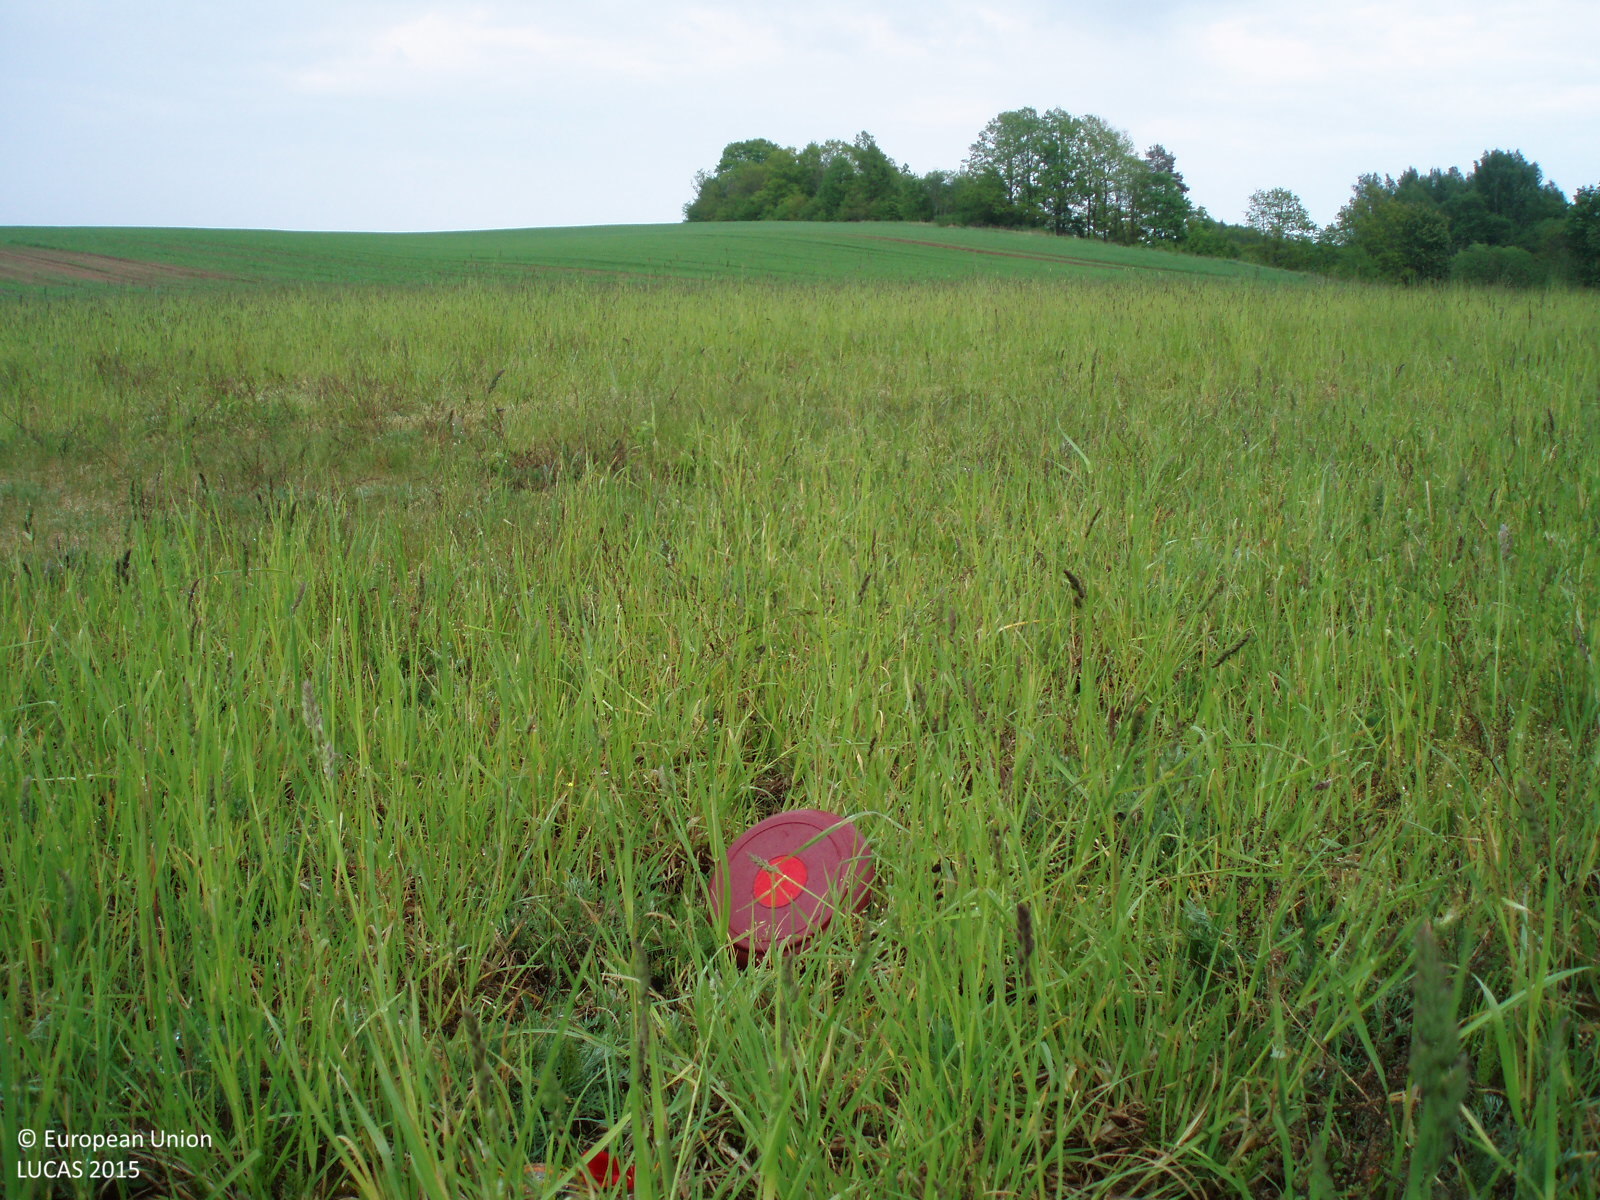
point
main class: Grassland
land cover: Grassland without tree/shrub cover
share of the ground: > 75 %
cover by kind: herbaceous plants 70 %, lichens and mosses 30 %
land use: Agriculture (excluding fallow land and kitchen gardens)
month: May
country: LT
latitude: 56.1531
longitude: 22.5356
